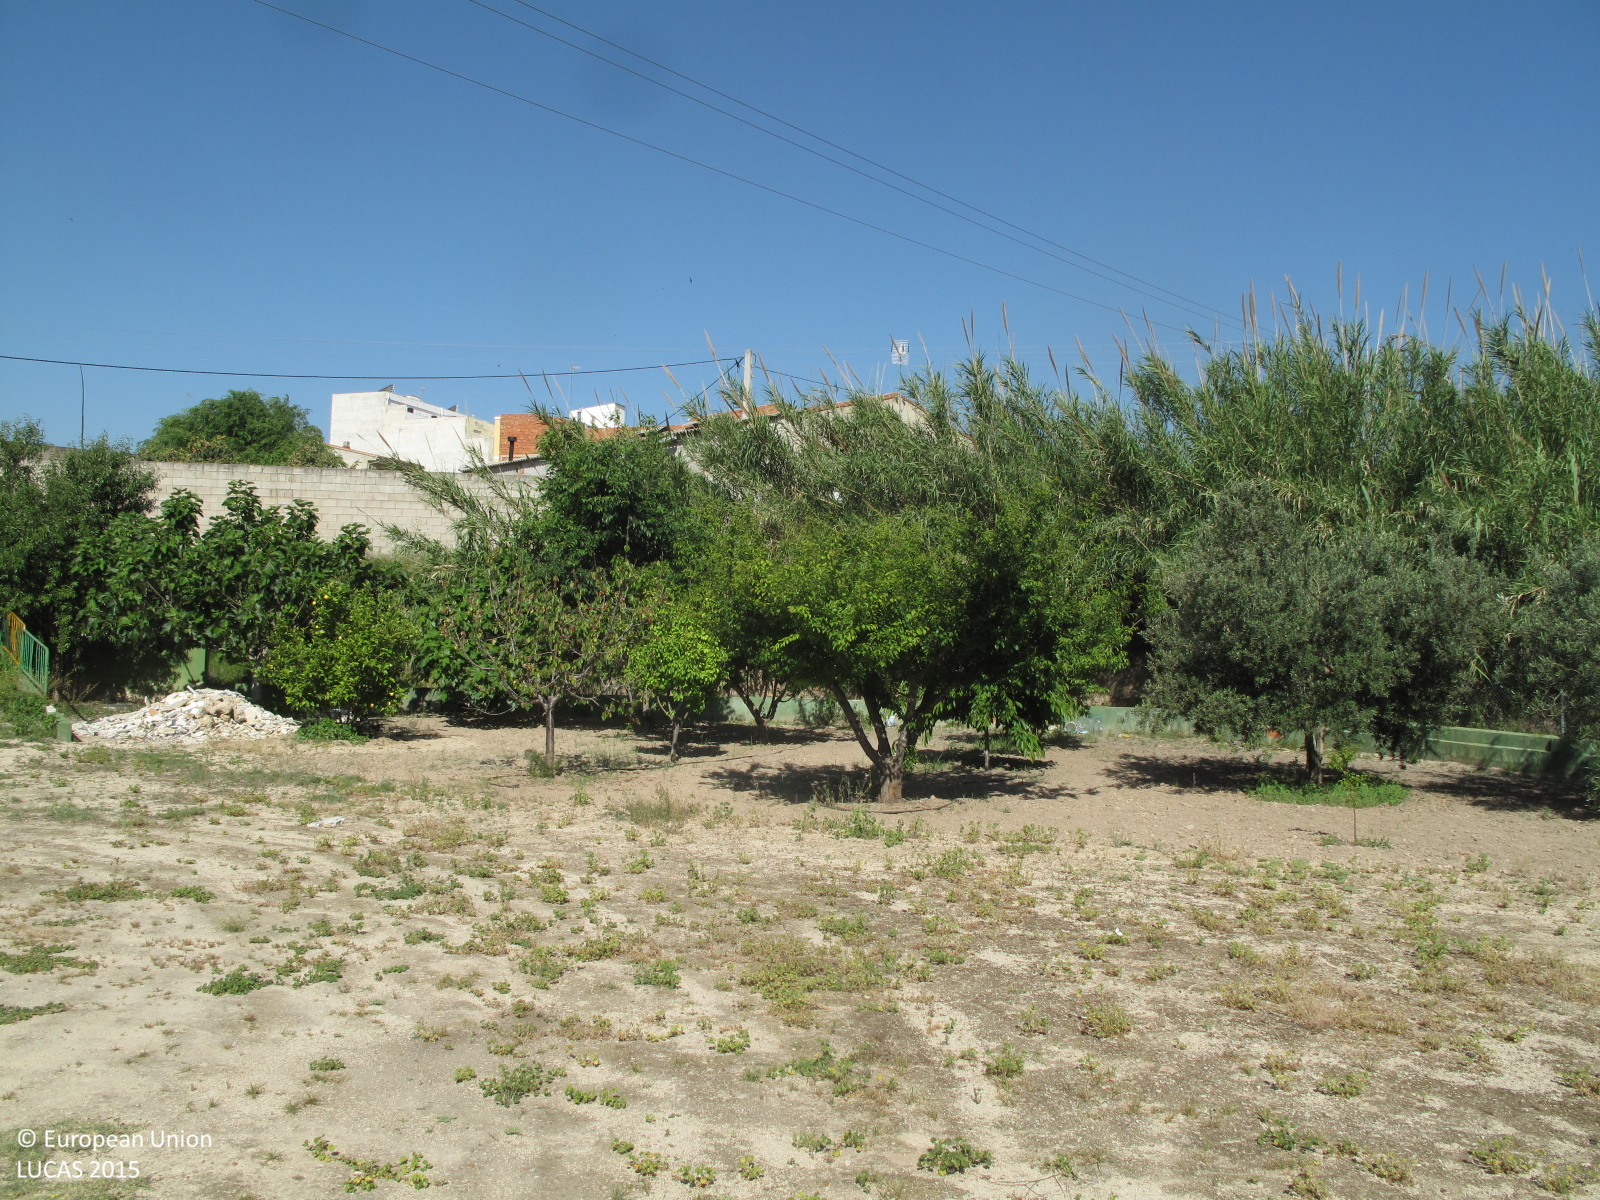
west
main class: Grassland
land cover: Spontaneously vegetated surfaces
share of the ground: 10 - 25 %
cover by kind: unconsolidated bare surface 90 %, herbaceous plants 10 %
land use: Residential
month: May
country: ES
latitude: 38.9644
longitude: -0.5757
